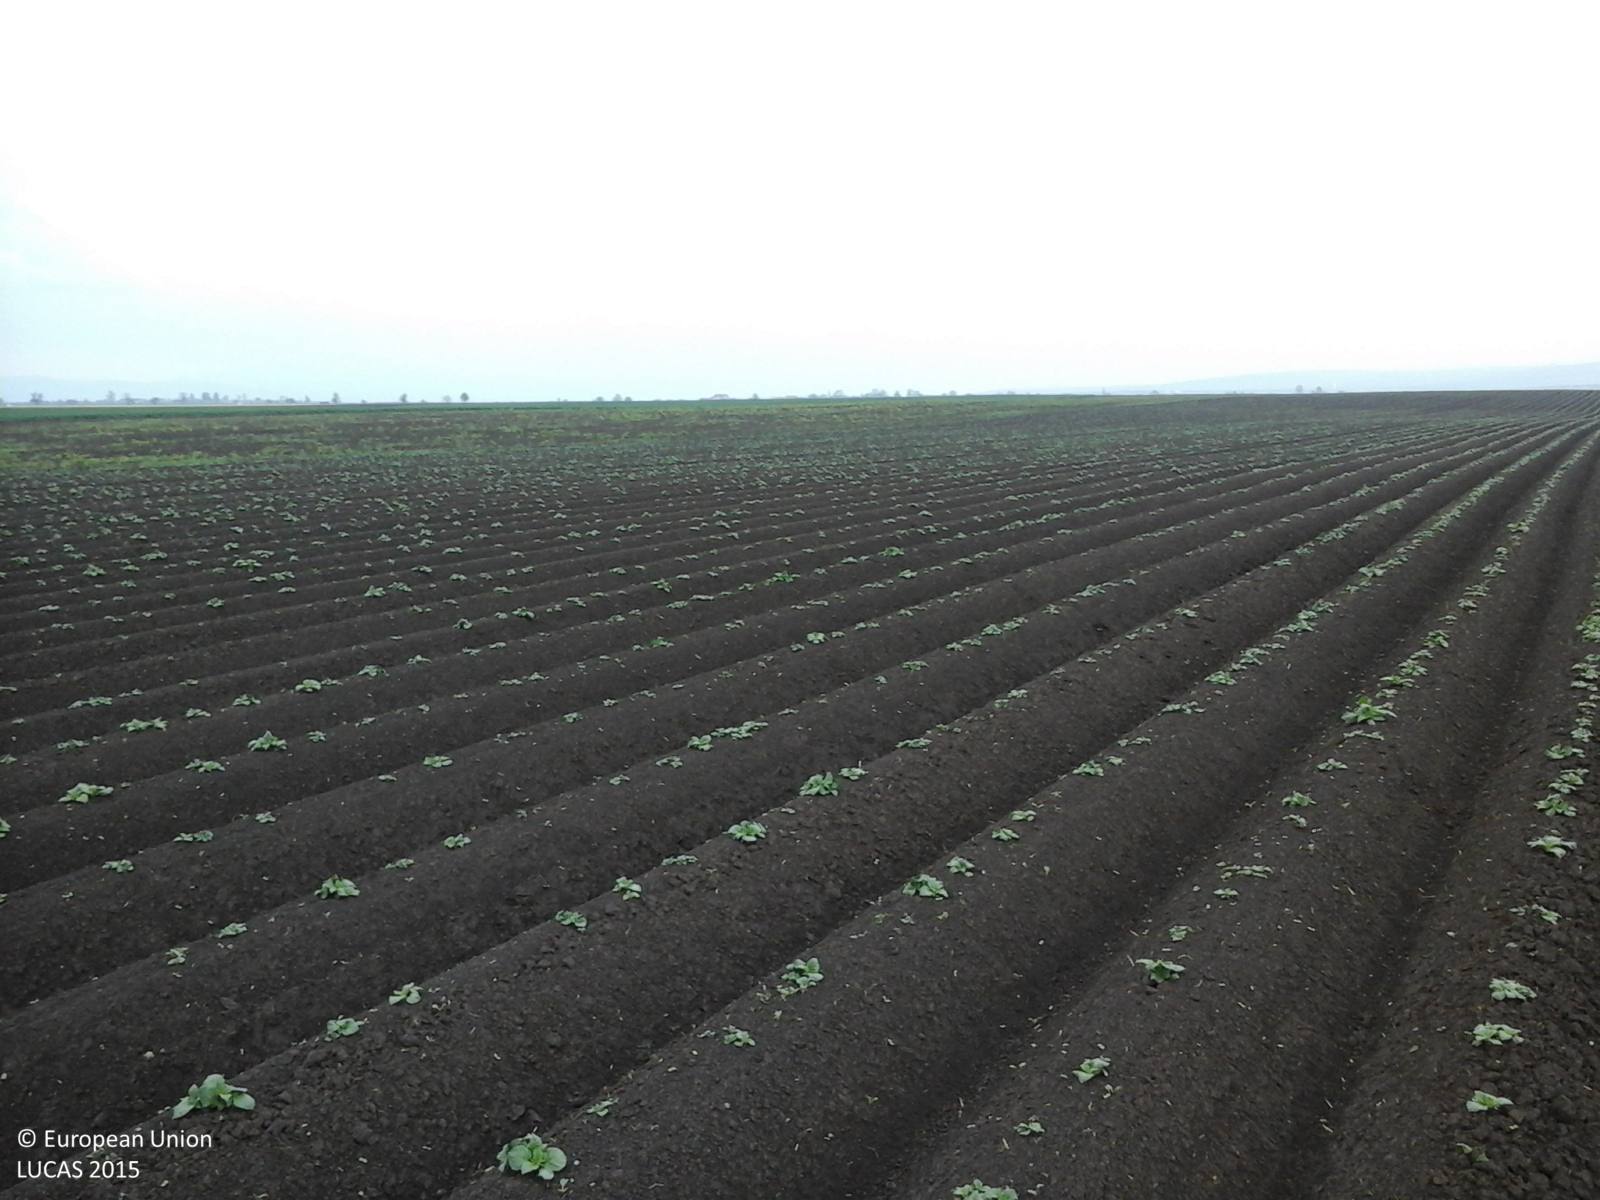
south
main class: Cropland
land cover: Potatoes
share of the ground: 10 - 25 %
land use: Agriculture (excluding fallow land and kitchen gardens)
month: May
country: RO
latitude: 45.9722
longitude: 26.0571
